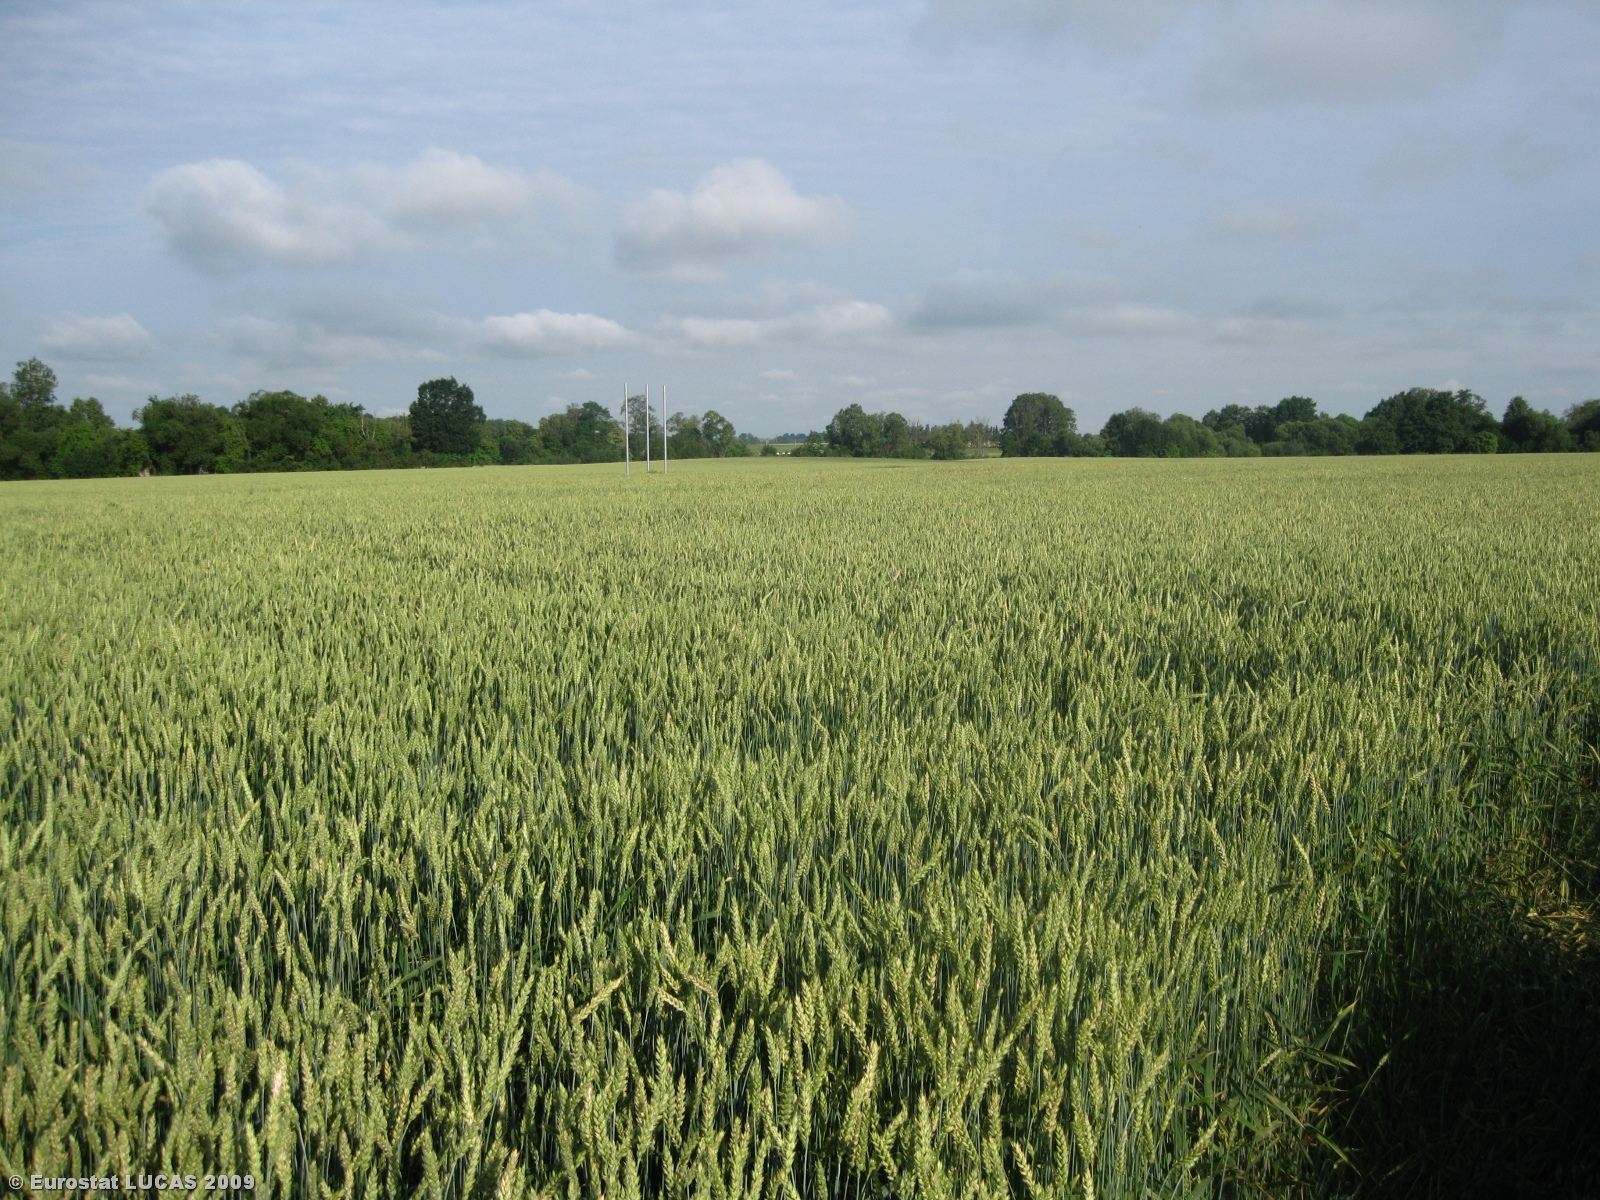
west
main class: Cropland
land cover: Common wheat
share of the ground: > 75 %
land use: Agriculture (excluding fallow land and kitchen gardens)
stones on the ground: < 10 %
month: July
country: LT
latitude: 54.6356
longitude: 23.4509
